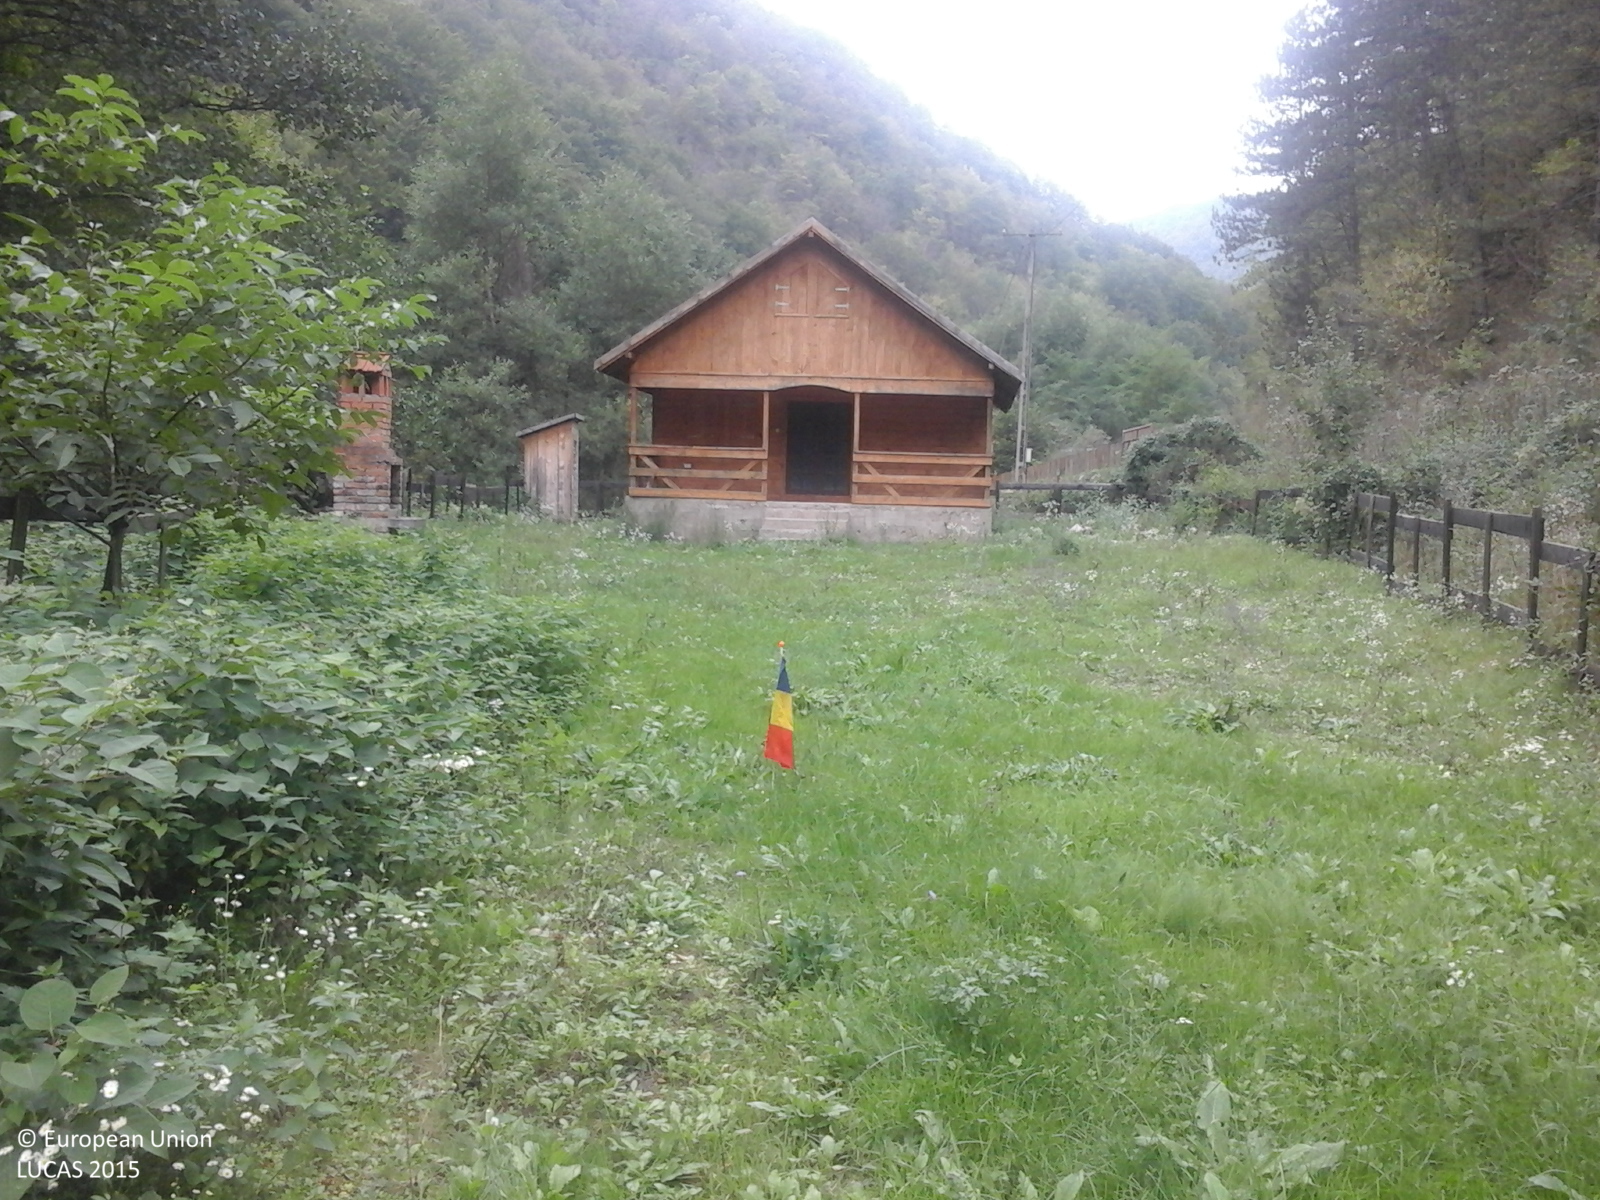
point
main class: Grassland
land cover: Grassland without tree/shrub cover
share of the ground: > 75 %
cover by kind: herbaceous plants 100 %
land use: Residential
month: September
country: RO
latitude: 45.7439
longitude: 22.7888
